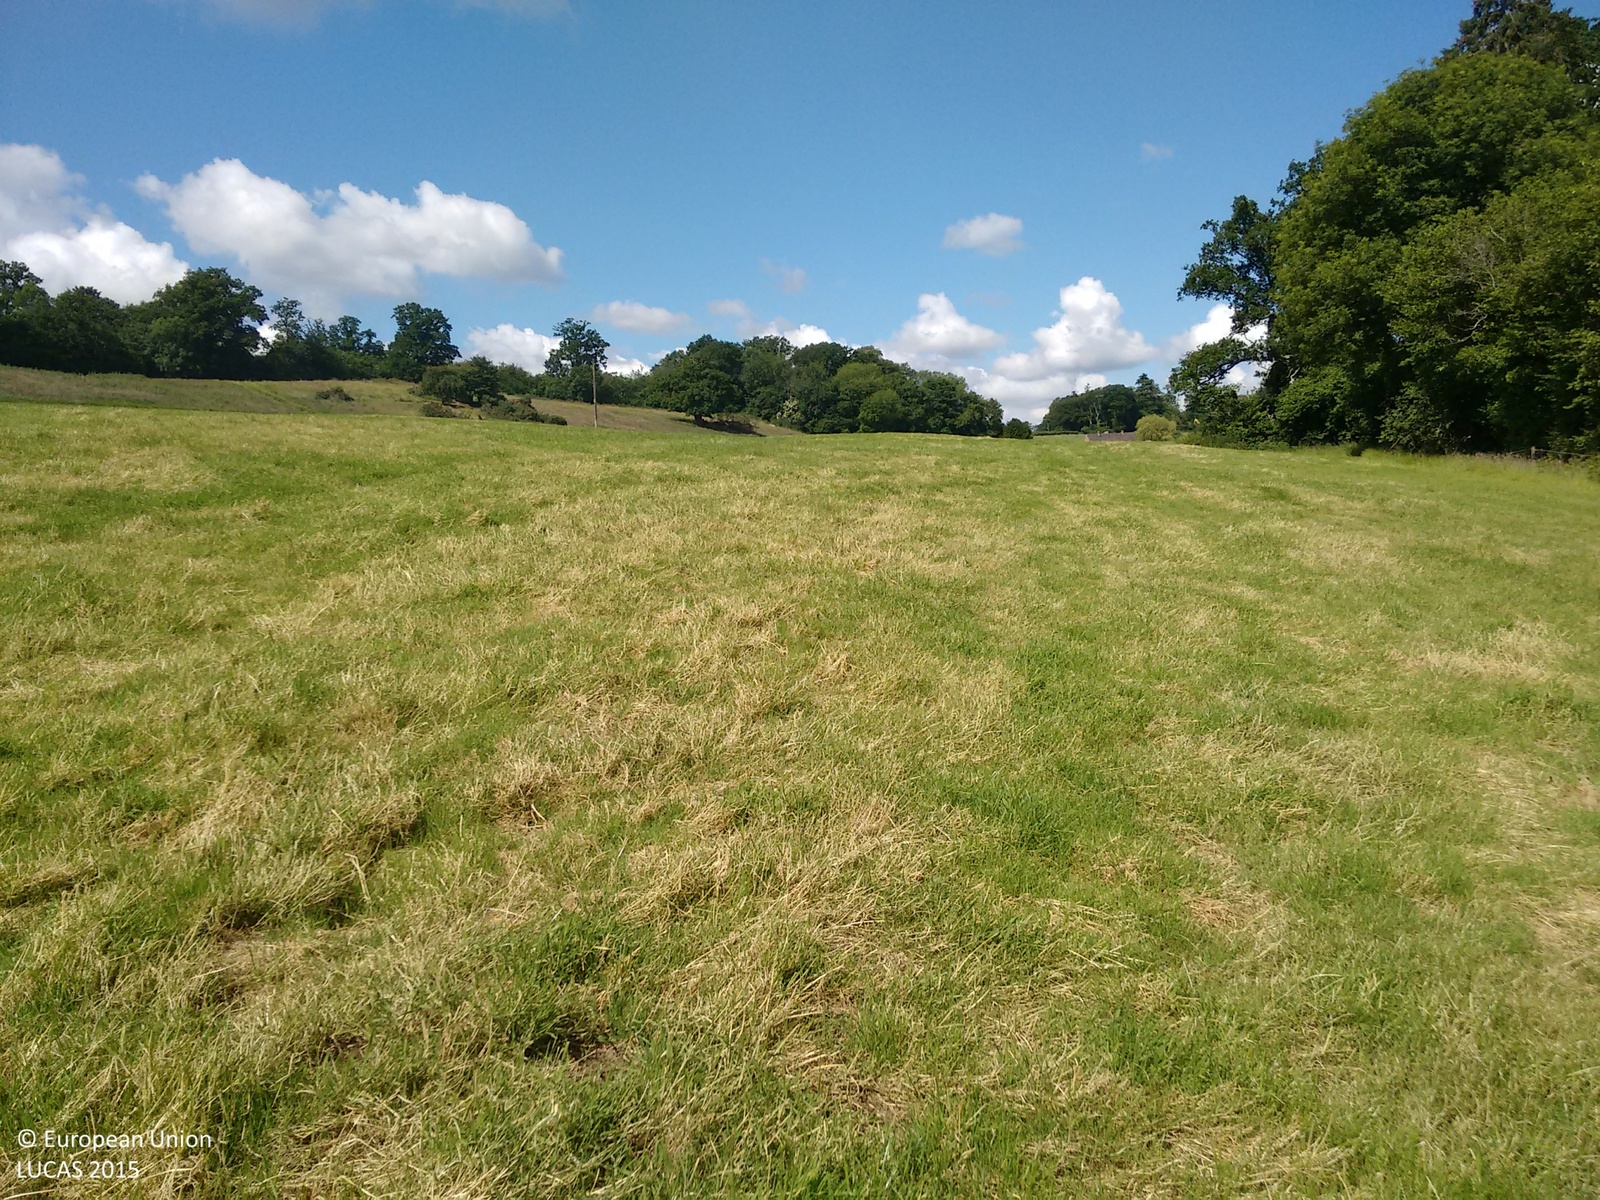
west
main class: Grassland
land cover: Grassland without tree/shrub cover
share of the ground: > 75 %
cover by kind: herbaceous plants 100 %
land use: Agriculture (excluding fallow land and kitchen gardens)
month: June
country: GB
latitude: 50.7501
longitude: -2.1505
